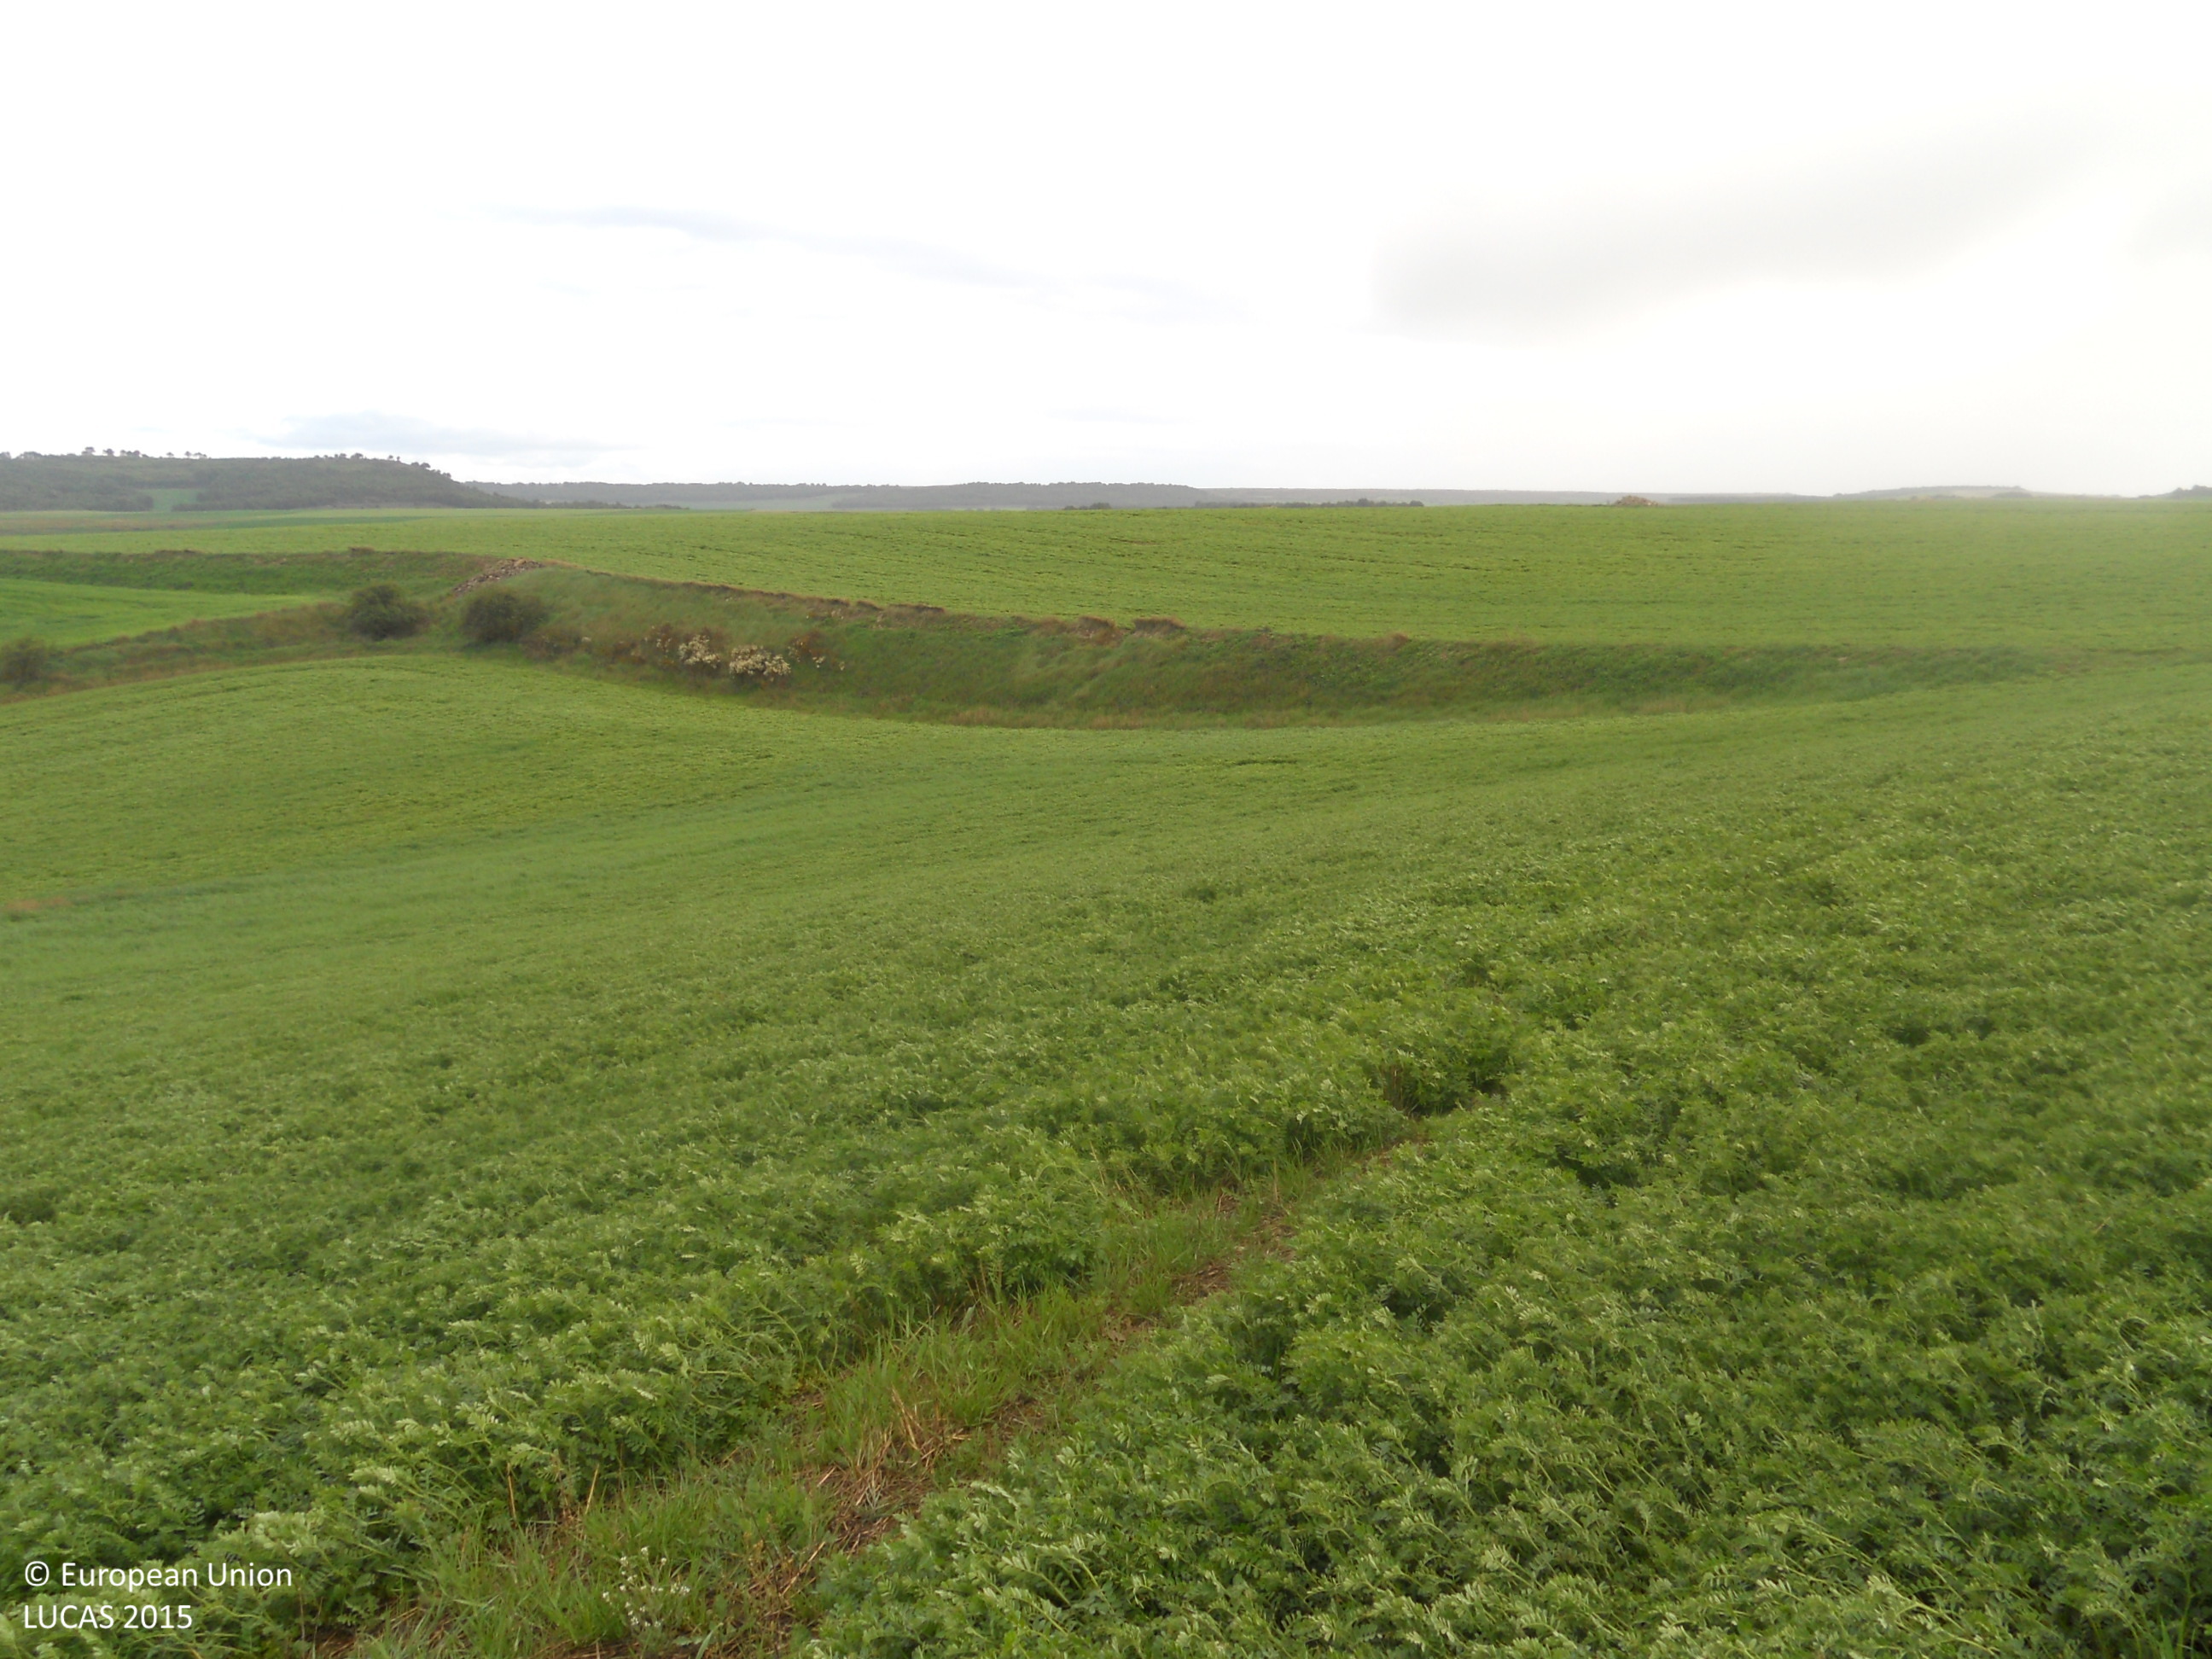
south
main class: Cropland
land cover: Dry pulses
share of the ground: > 75 %
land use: Agriculture (excluding fallow land and kitchen gardens)
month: April
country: ES
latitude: 42.2121
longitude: -4.3508
